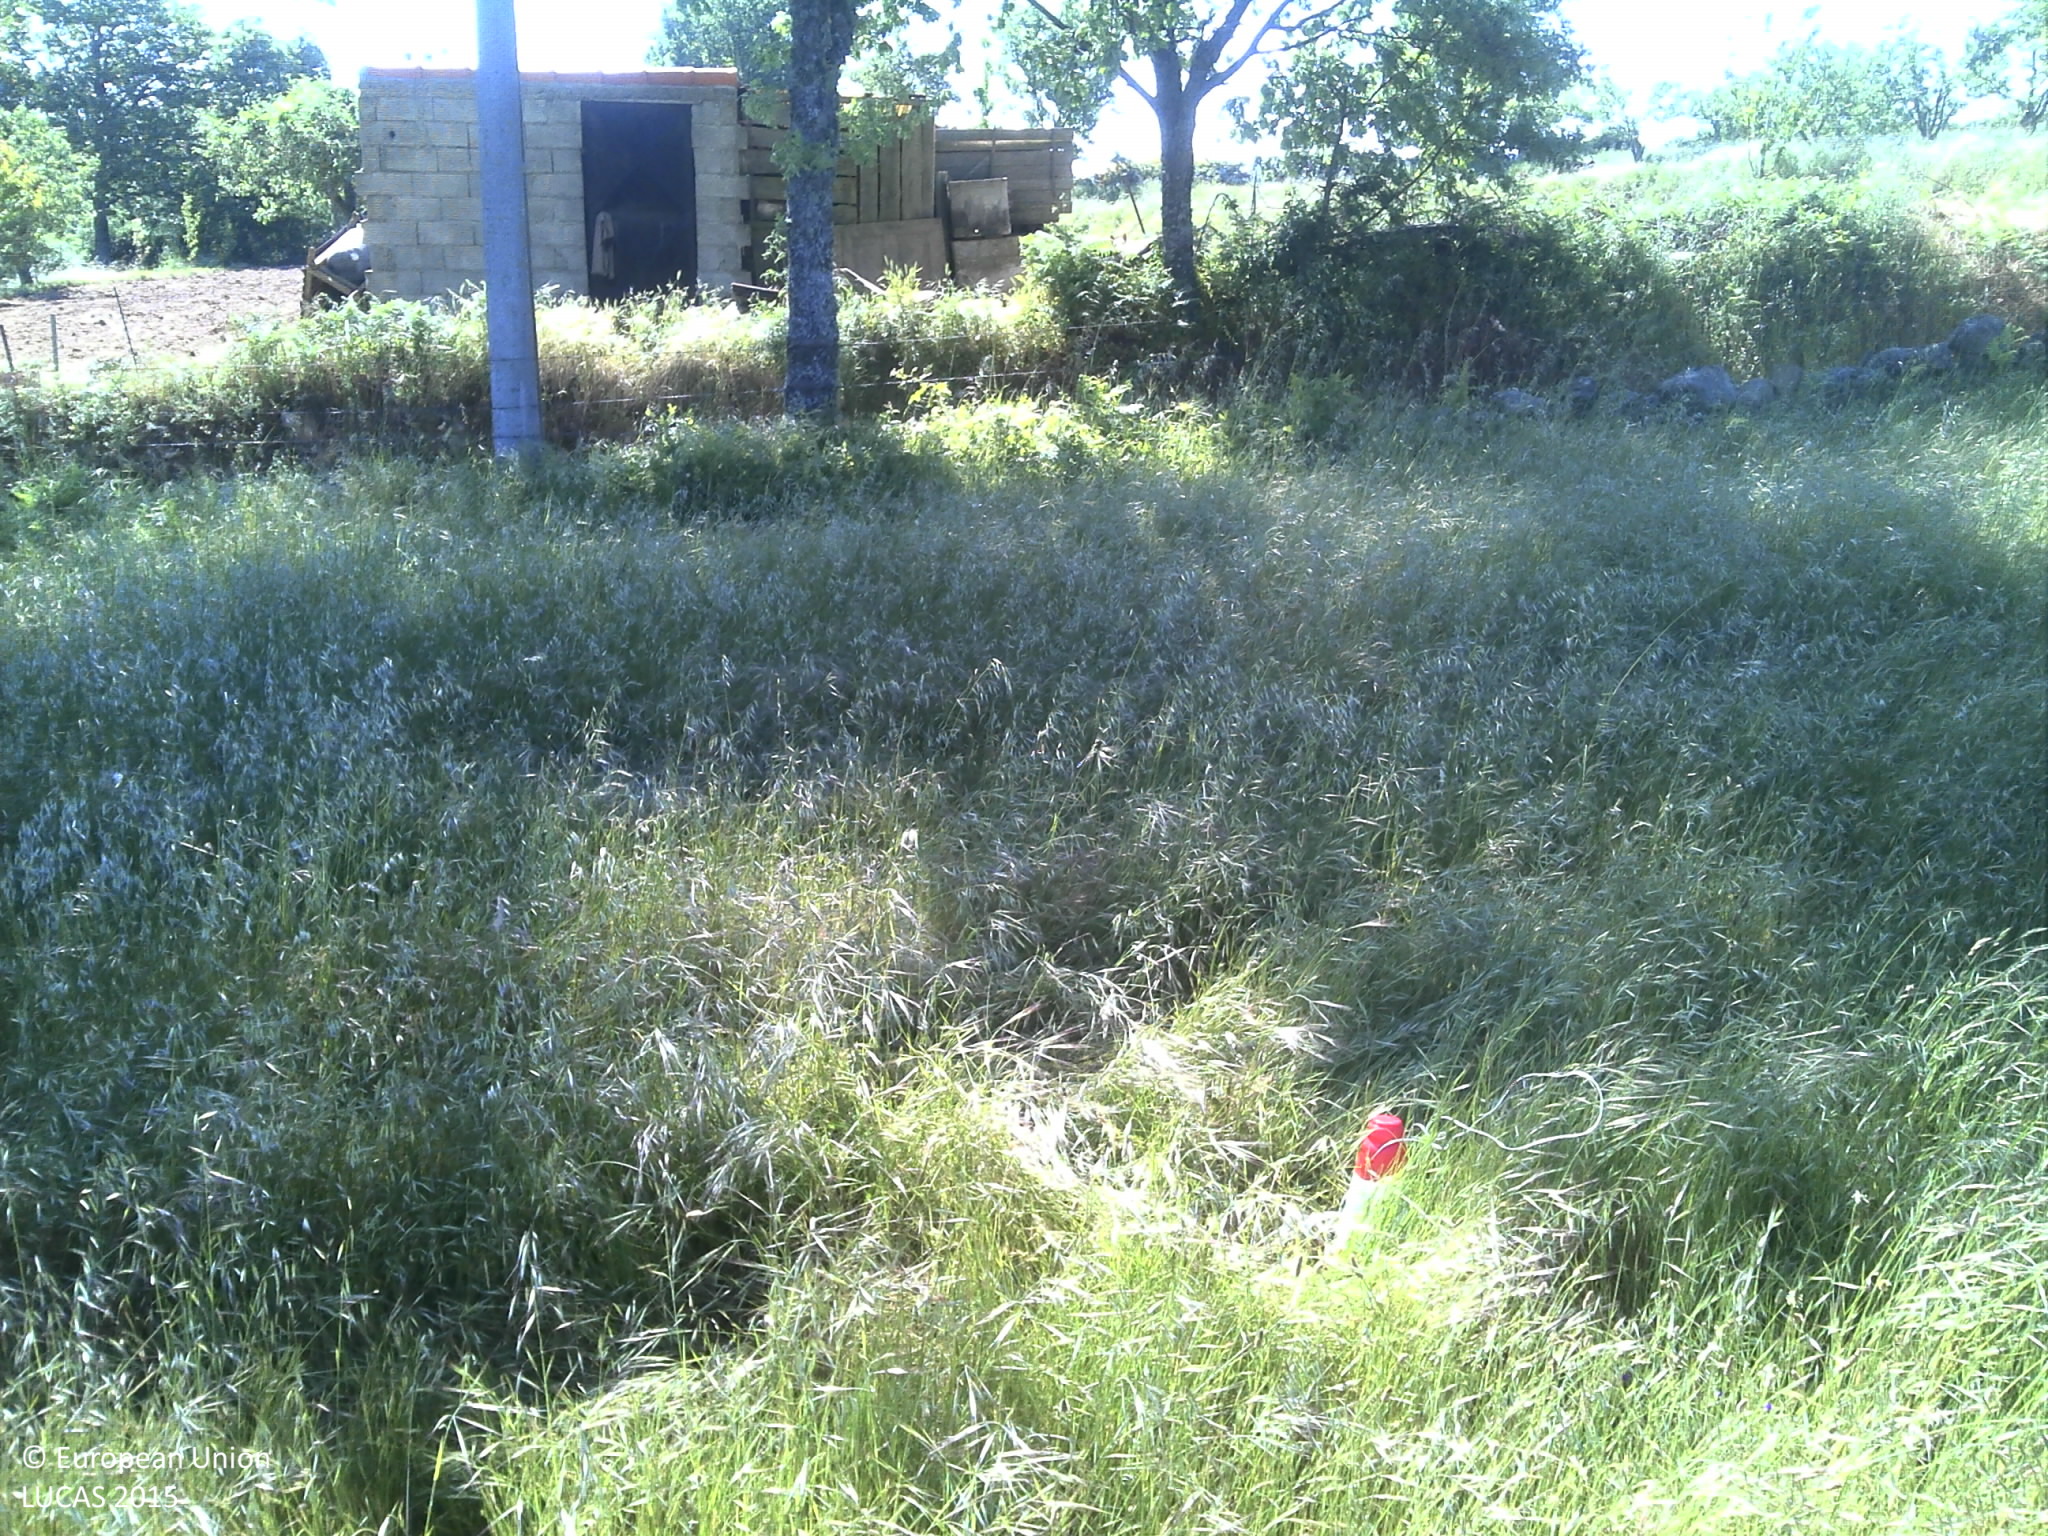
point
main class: Grassland
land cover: Grassland without tree/shrub cover
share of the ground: 25 - 50 %
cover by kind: herbaceous plants 65 %, unconsolidated bare surface 25 %
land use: Agriculture (excluding fallow land and kitchen gardens)
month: May
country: PT
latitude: 40.5934
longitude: -7.2274
